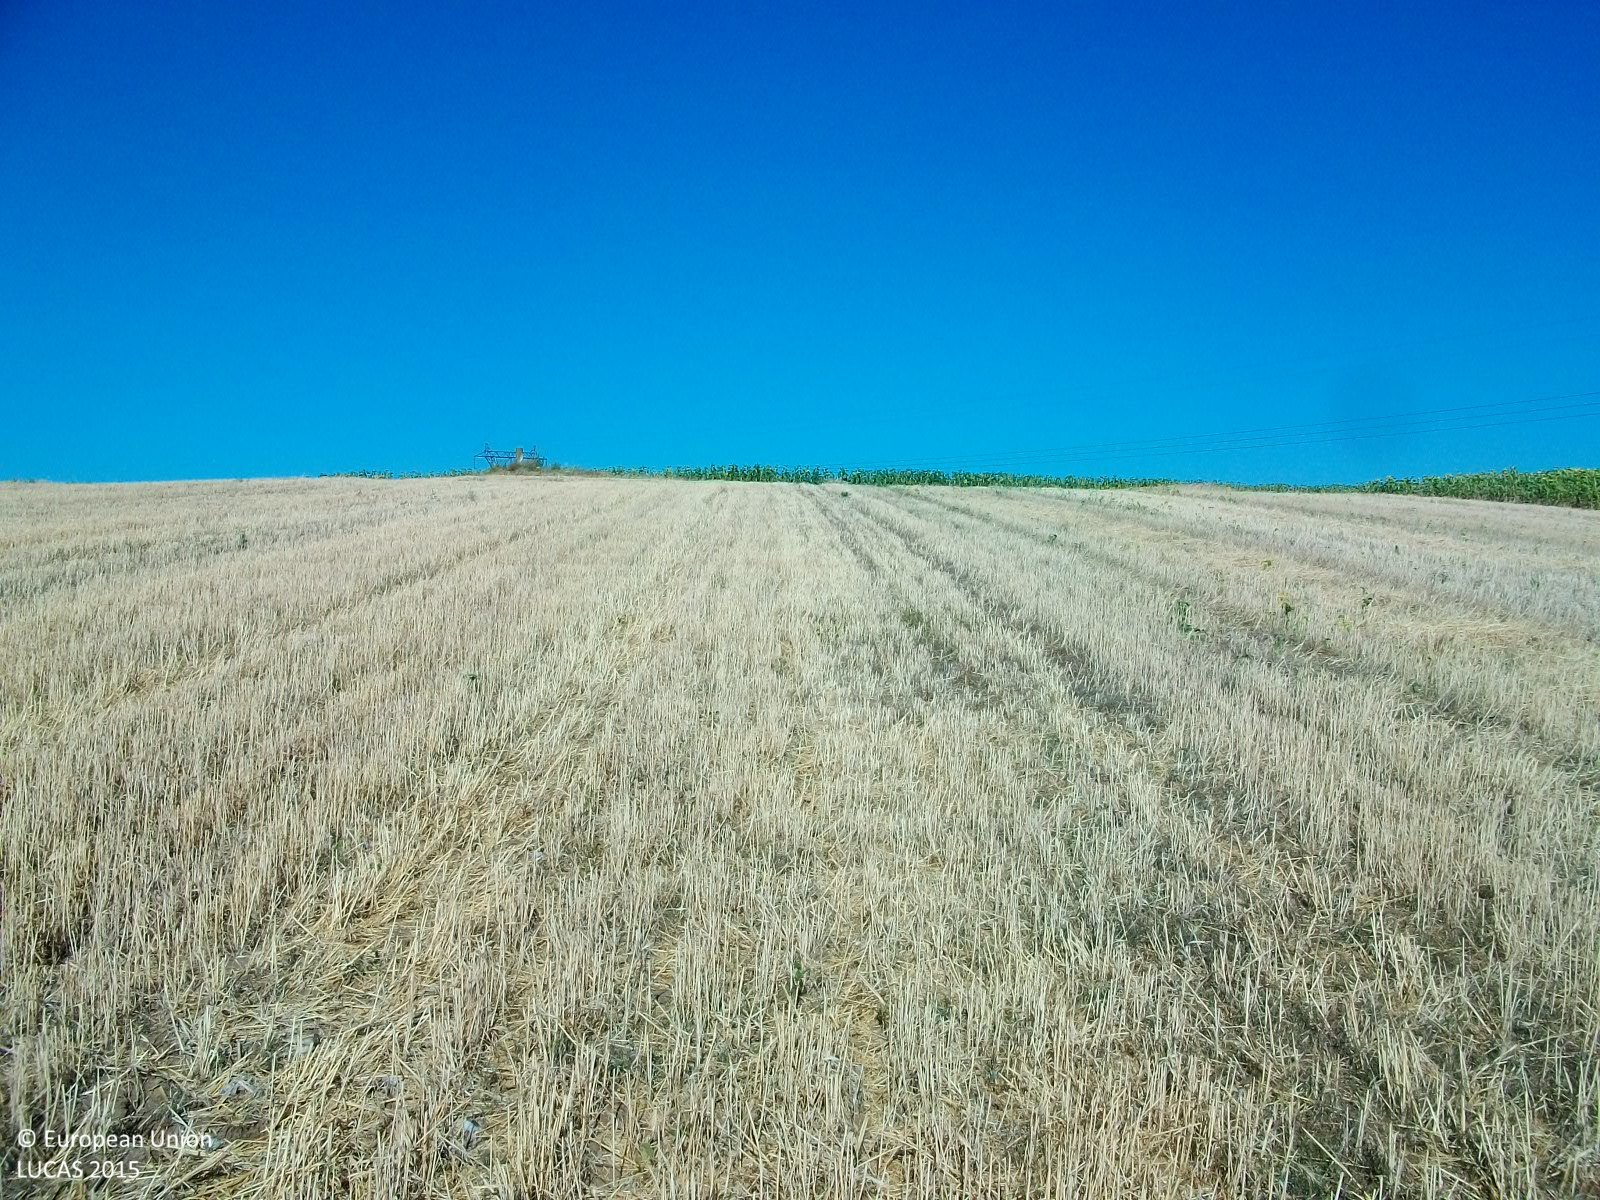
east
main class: Cropland
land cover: Common wheat
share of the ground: > 75 %
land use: Agriculture (excluding fallow land and kitchen gardens)
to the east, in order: Common wheat; Grass margins; Sunflower; Grass margins; Cotton; Electric lines; Cotton
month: July
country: GR
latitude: 41.4667
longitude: 26.3221
